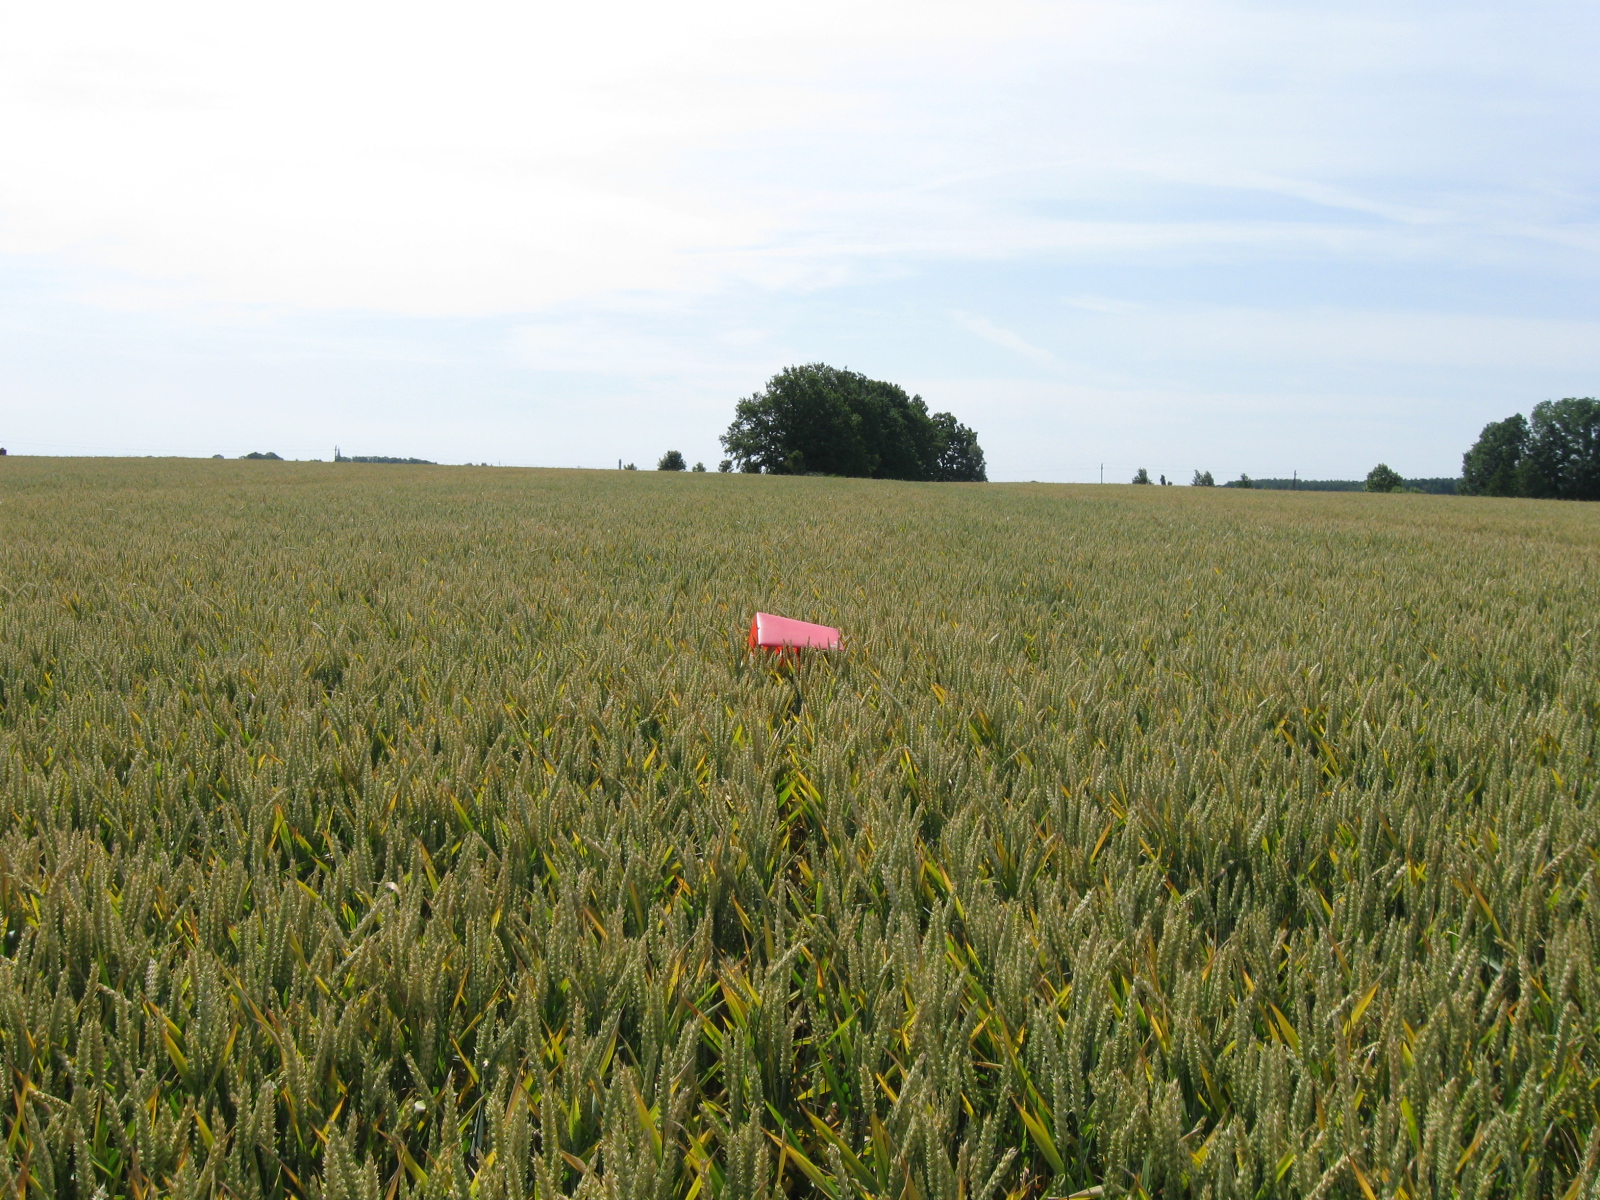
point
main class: Cropland
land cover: Common wheat
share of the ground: > 75 %
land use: Agriculture (excluding fallow land and kitchen gardens)
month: July
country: LT
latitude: 54.7499
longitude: 23.9013
